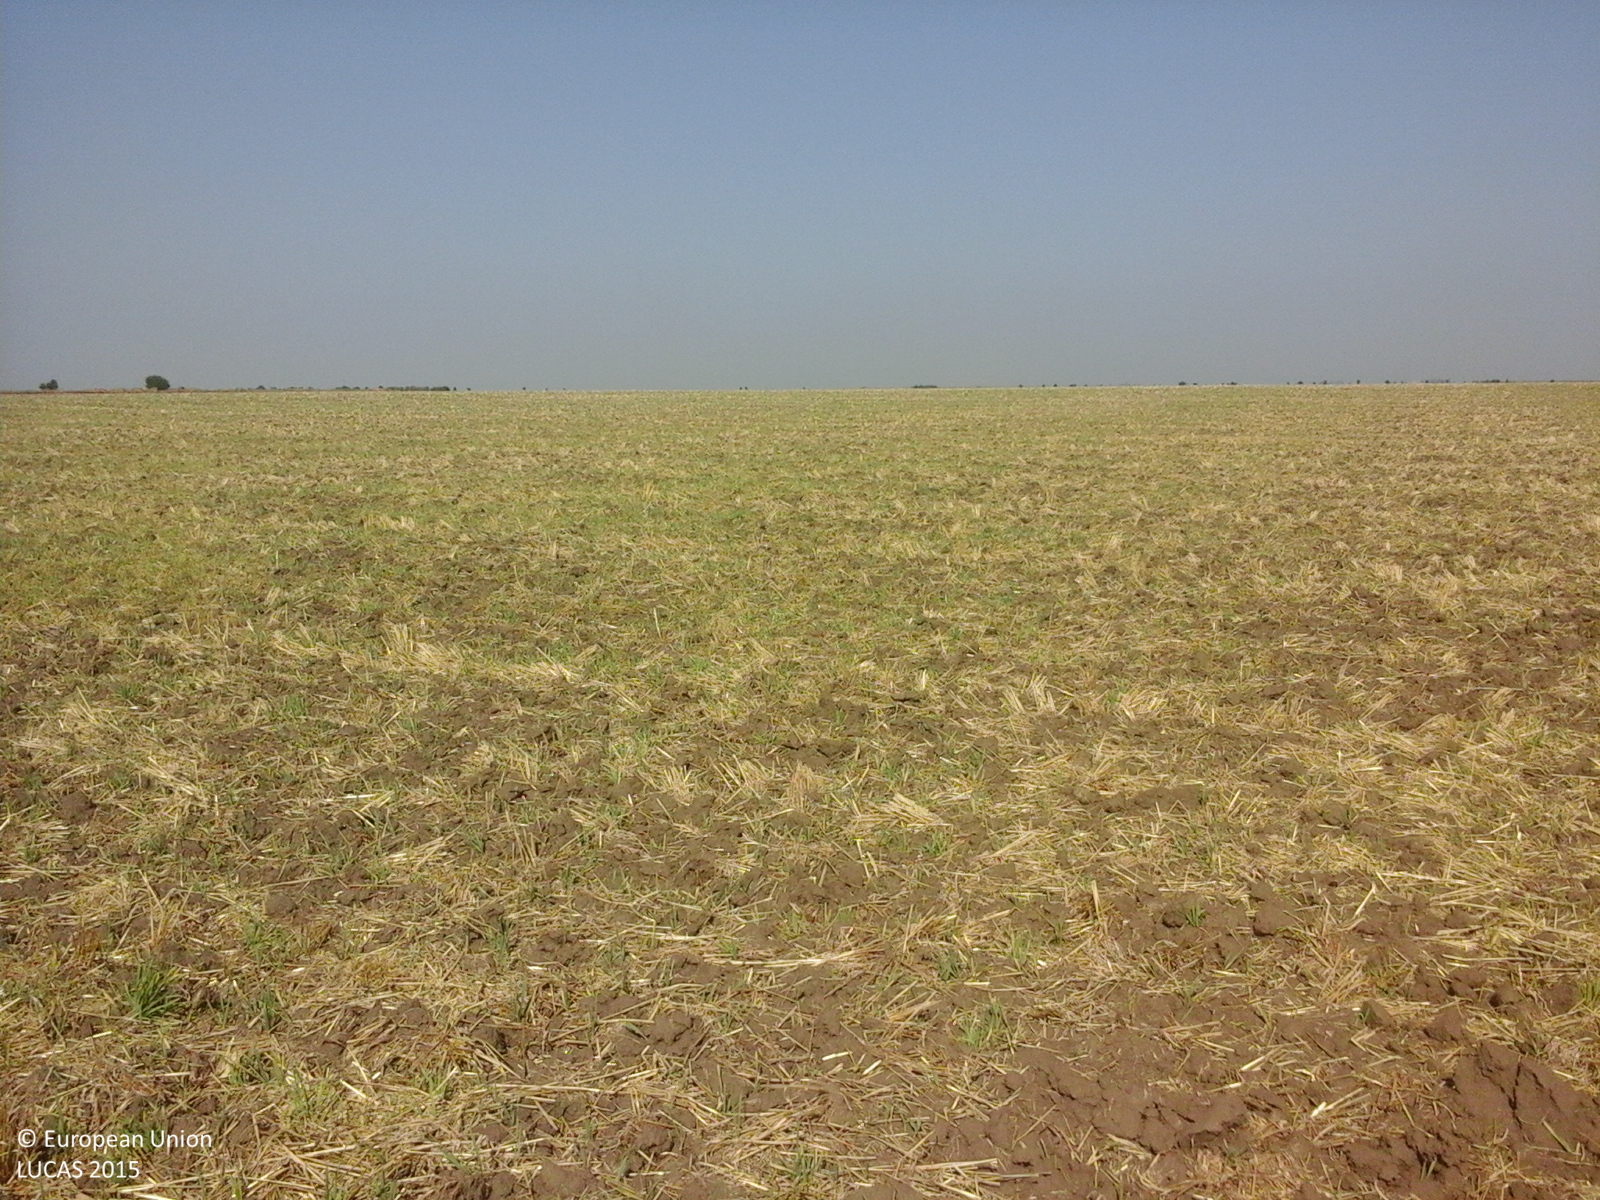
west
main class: Cropland
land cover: Common wheat
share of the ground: 10 - 25 %
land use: Agriculture (excluding fallow land and kitchen gardens)
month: July
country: RO
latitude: 44.3922
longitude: 27.0904
